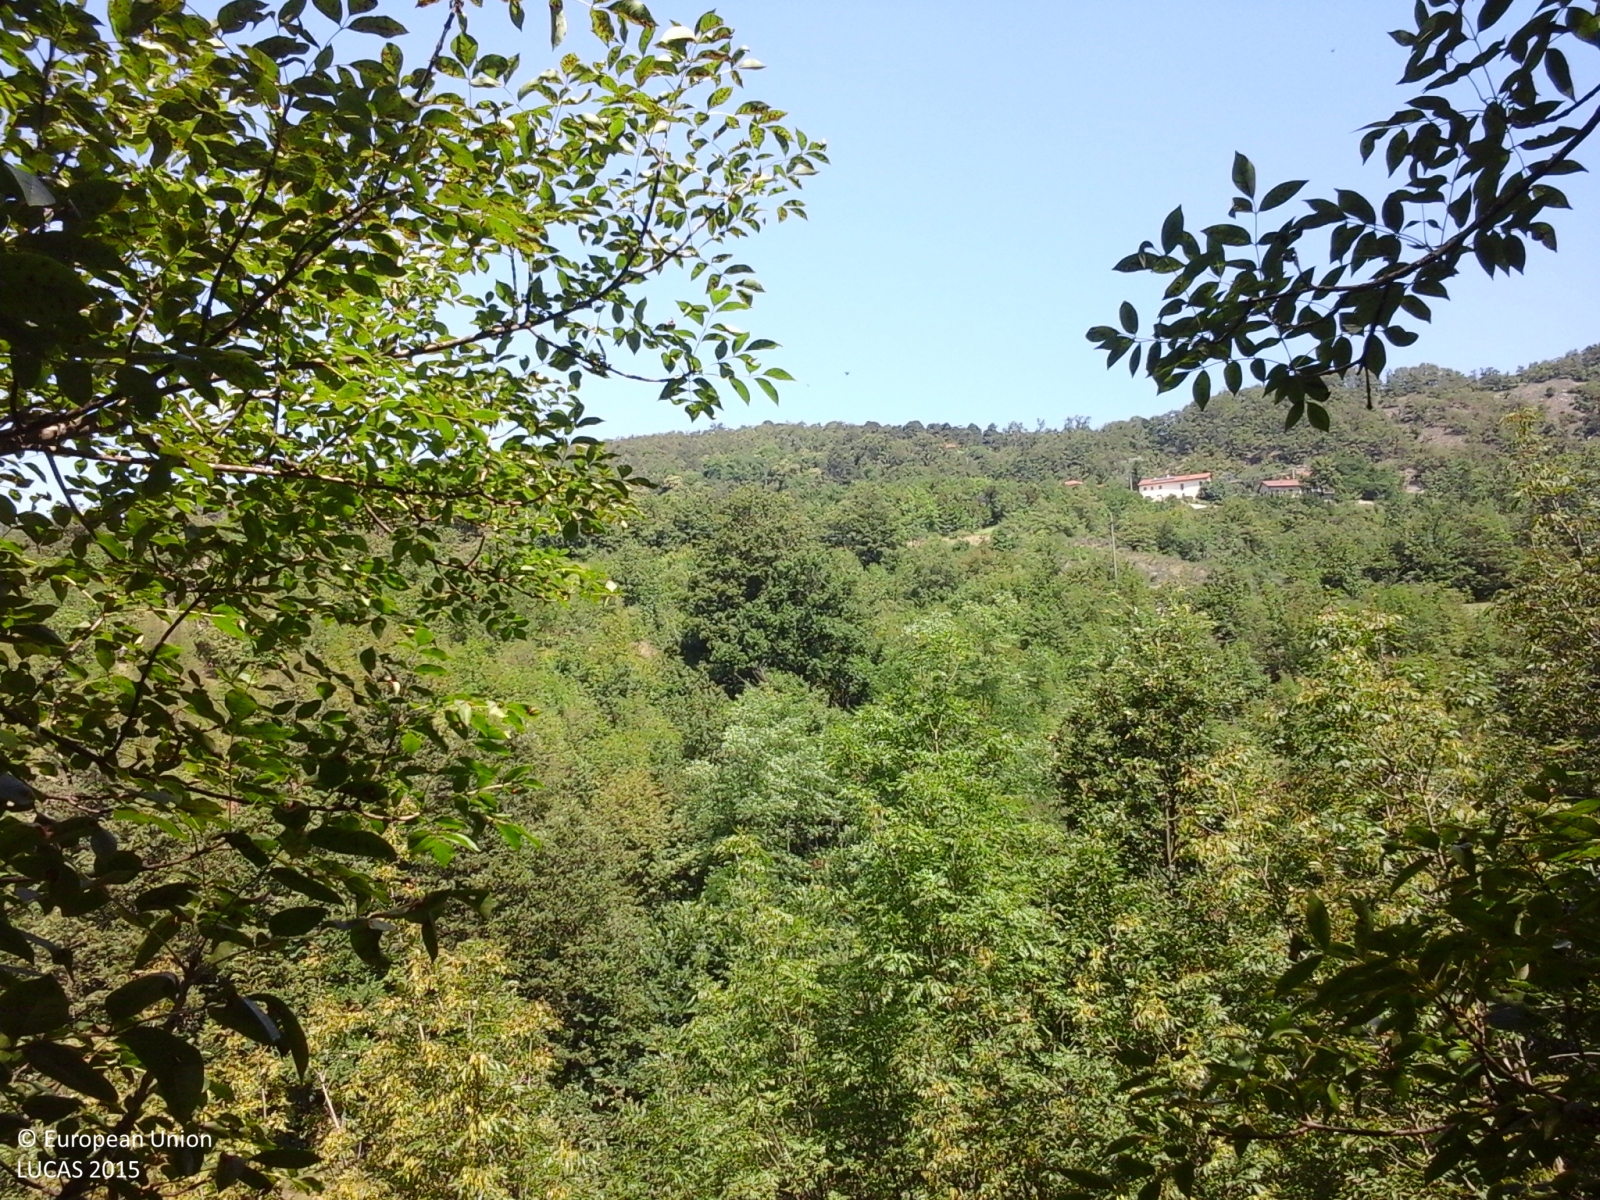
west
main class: Woodland
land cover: Broadleaved woodland
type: thermophilous deciduous forest
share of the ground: > 75 %
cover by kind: broadleaved forest trees 85 %, herbaceous plants 10 %, shrubs 5 %
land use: Semi-natural and natural areas not in use
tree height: < 5 m
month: June
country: IT
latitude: 44.5175
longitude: 8.3303
